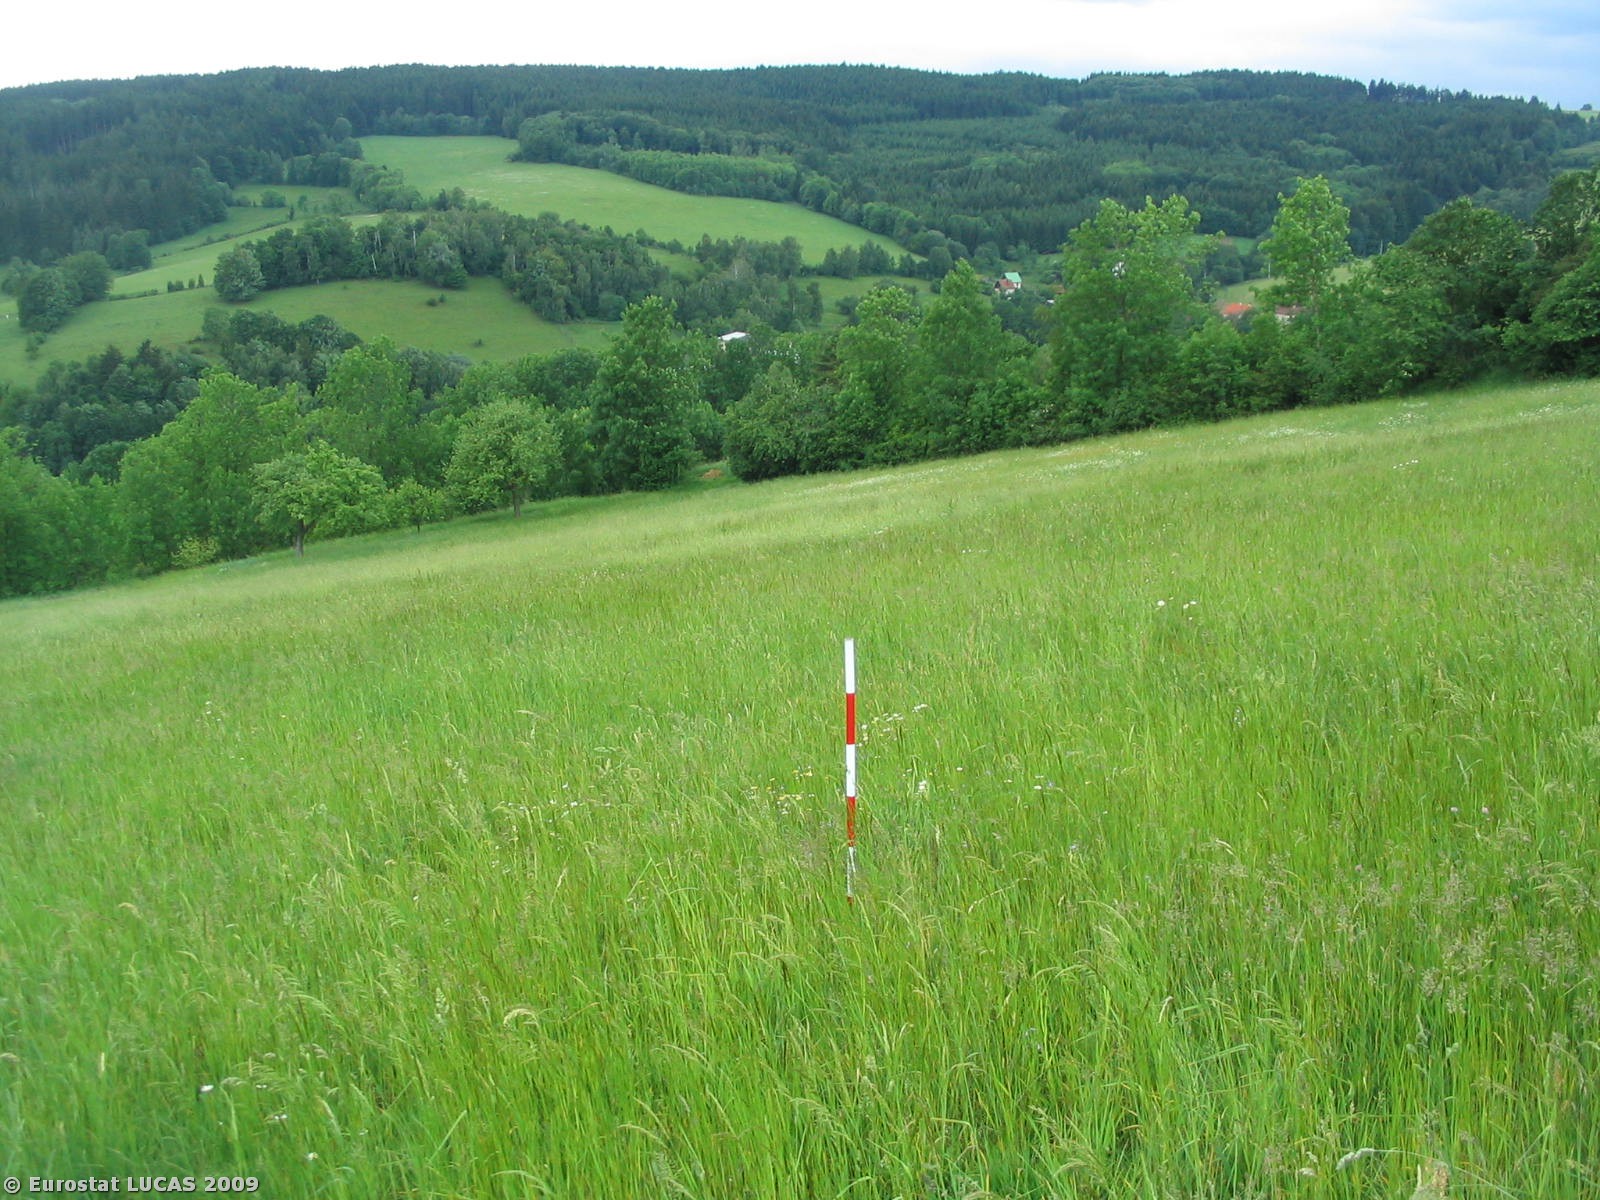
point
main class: Grassland
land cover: Grassland without tree/shrub cover
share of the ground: > 75 %
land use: Agriculture (excluding fallow land and kitchen gardens)
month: May
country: CZ
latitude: 49.4946
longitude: 16.4823
